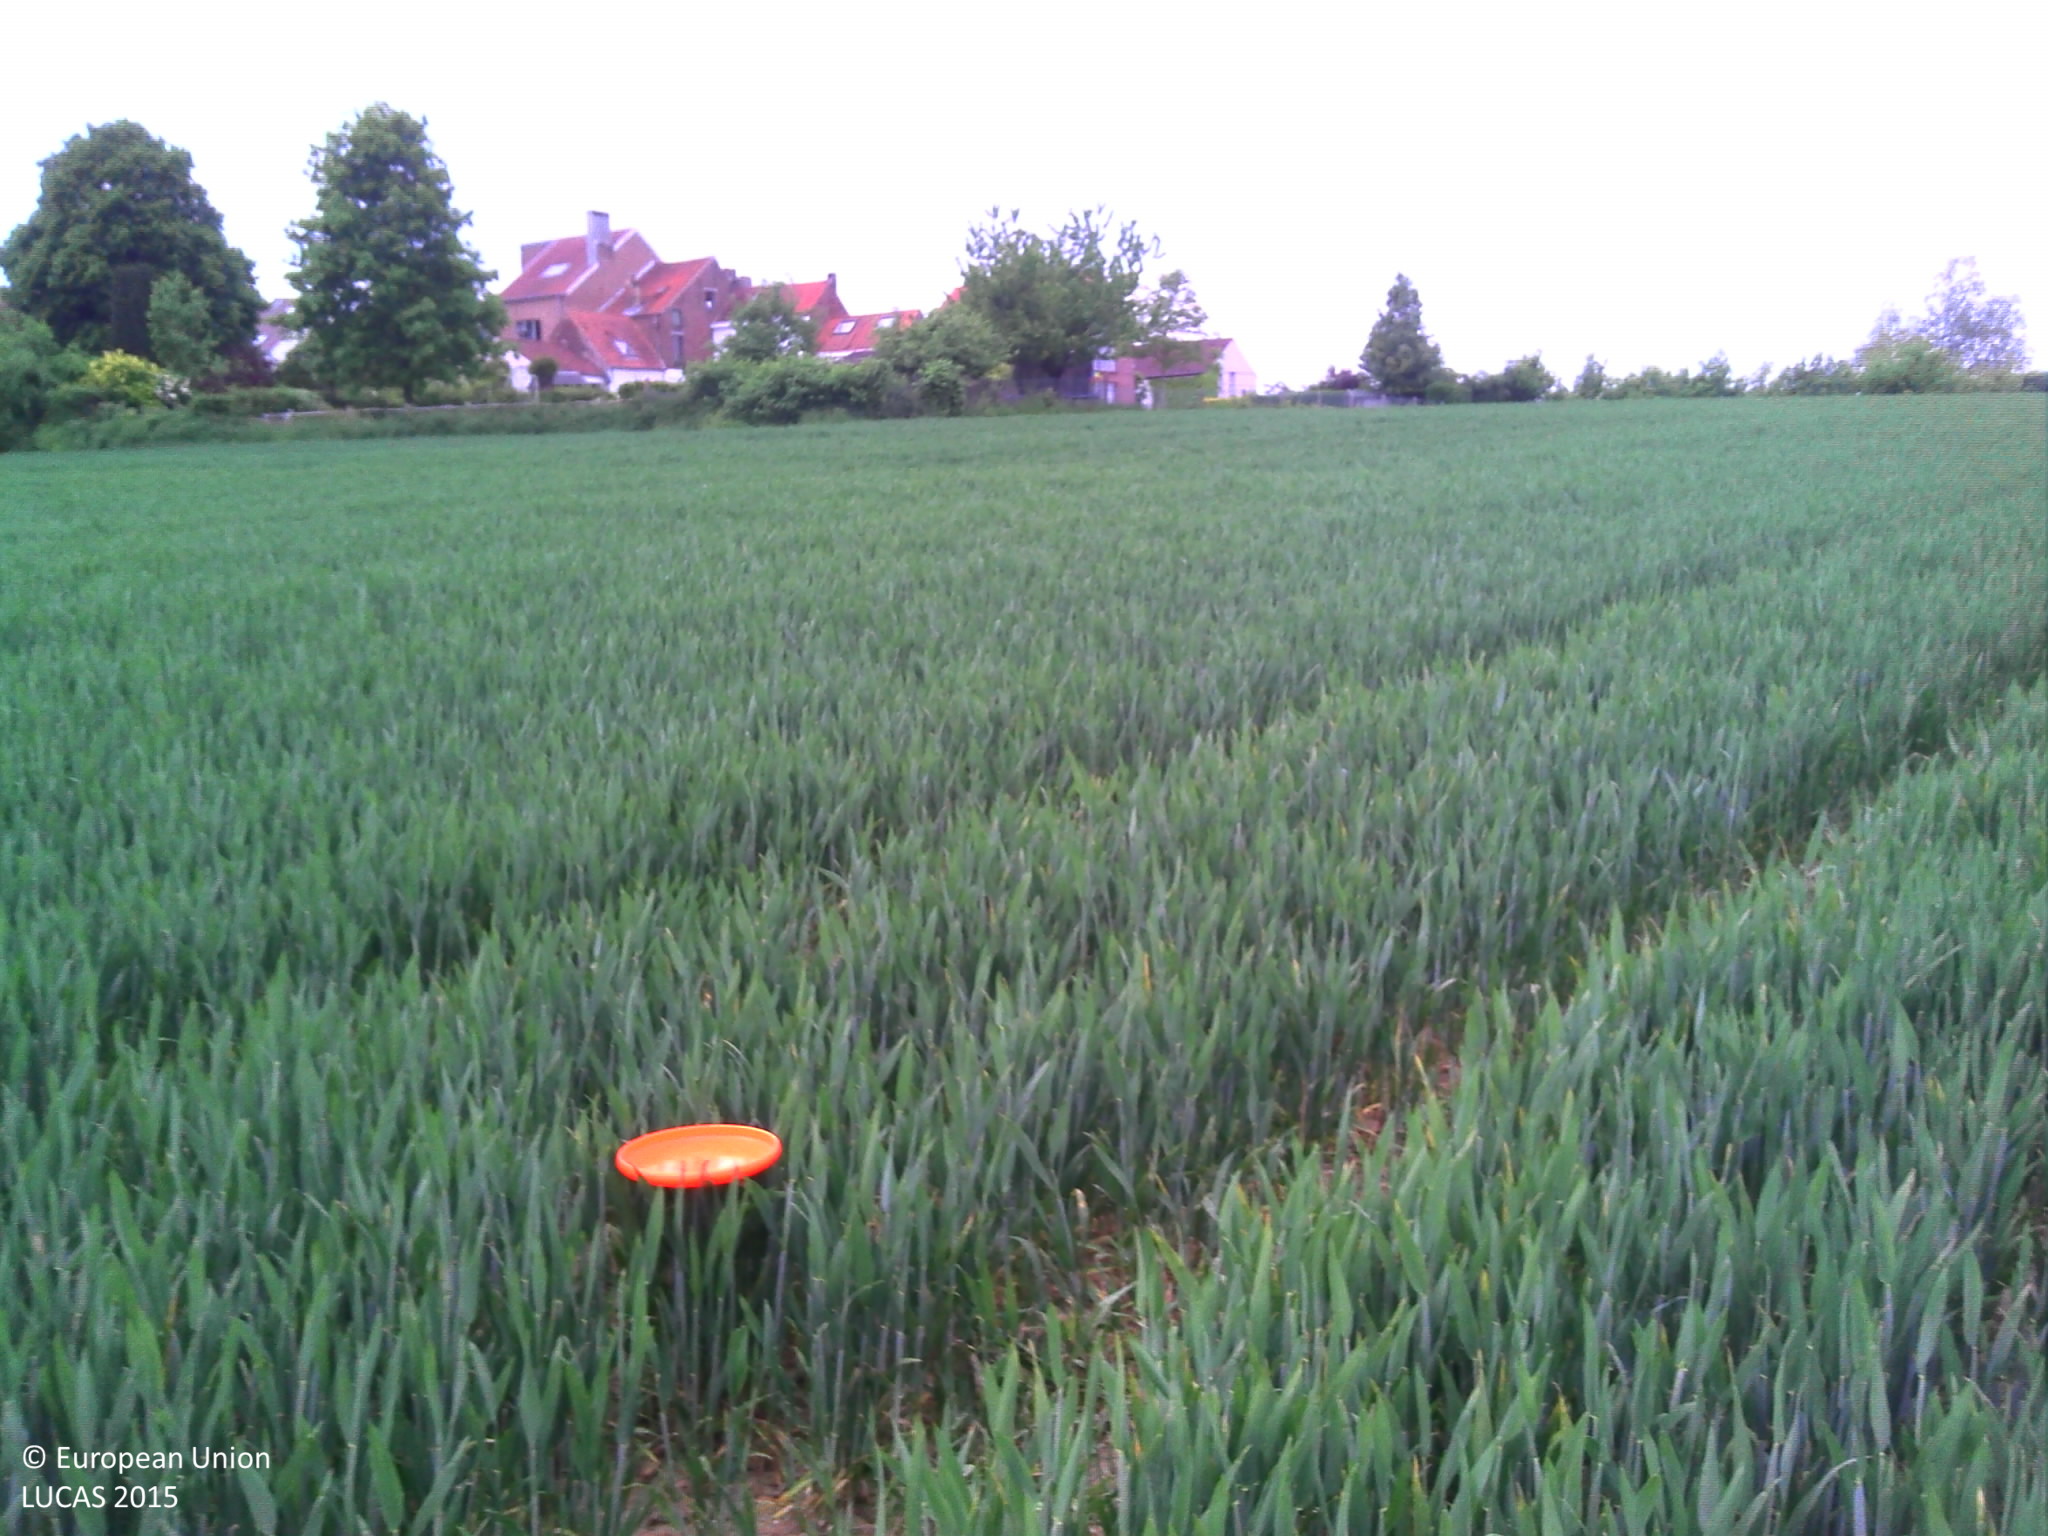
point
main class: Cropland
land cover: Common wheat
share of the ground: > 75 %
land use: Agriculture (excluding fallow land and kitchen gardens)
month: May
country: BE
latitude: 50.6626
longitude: 4.4642
